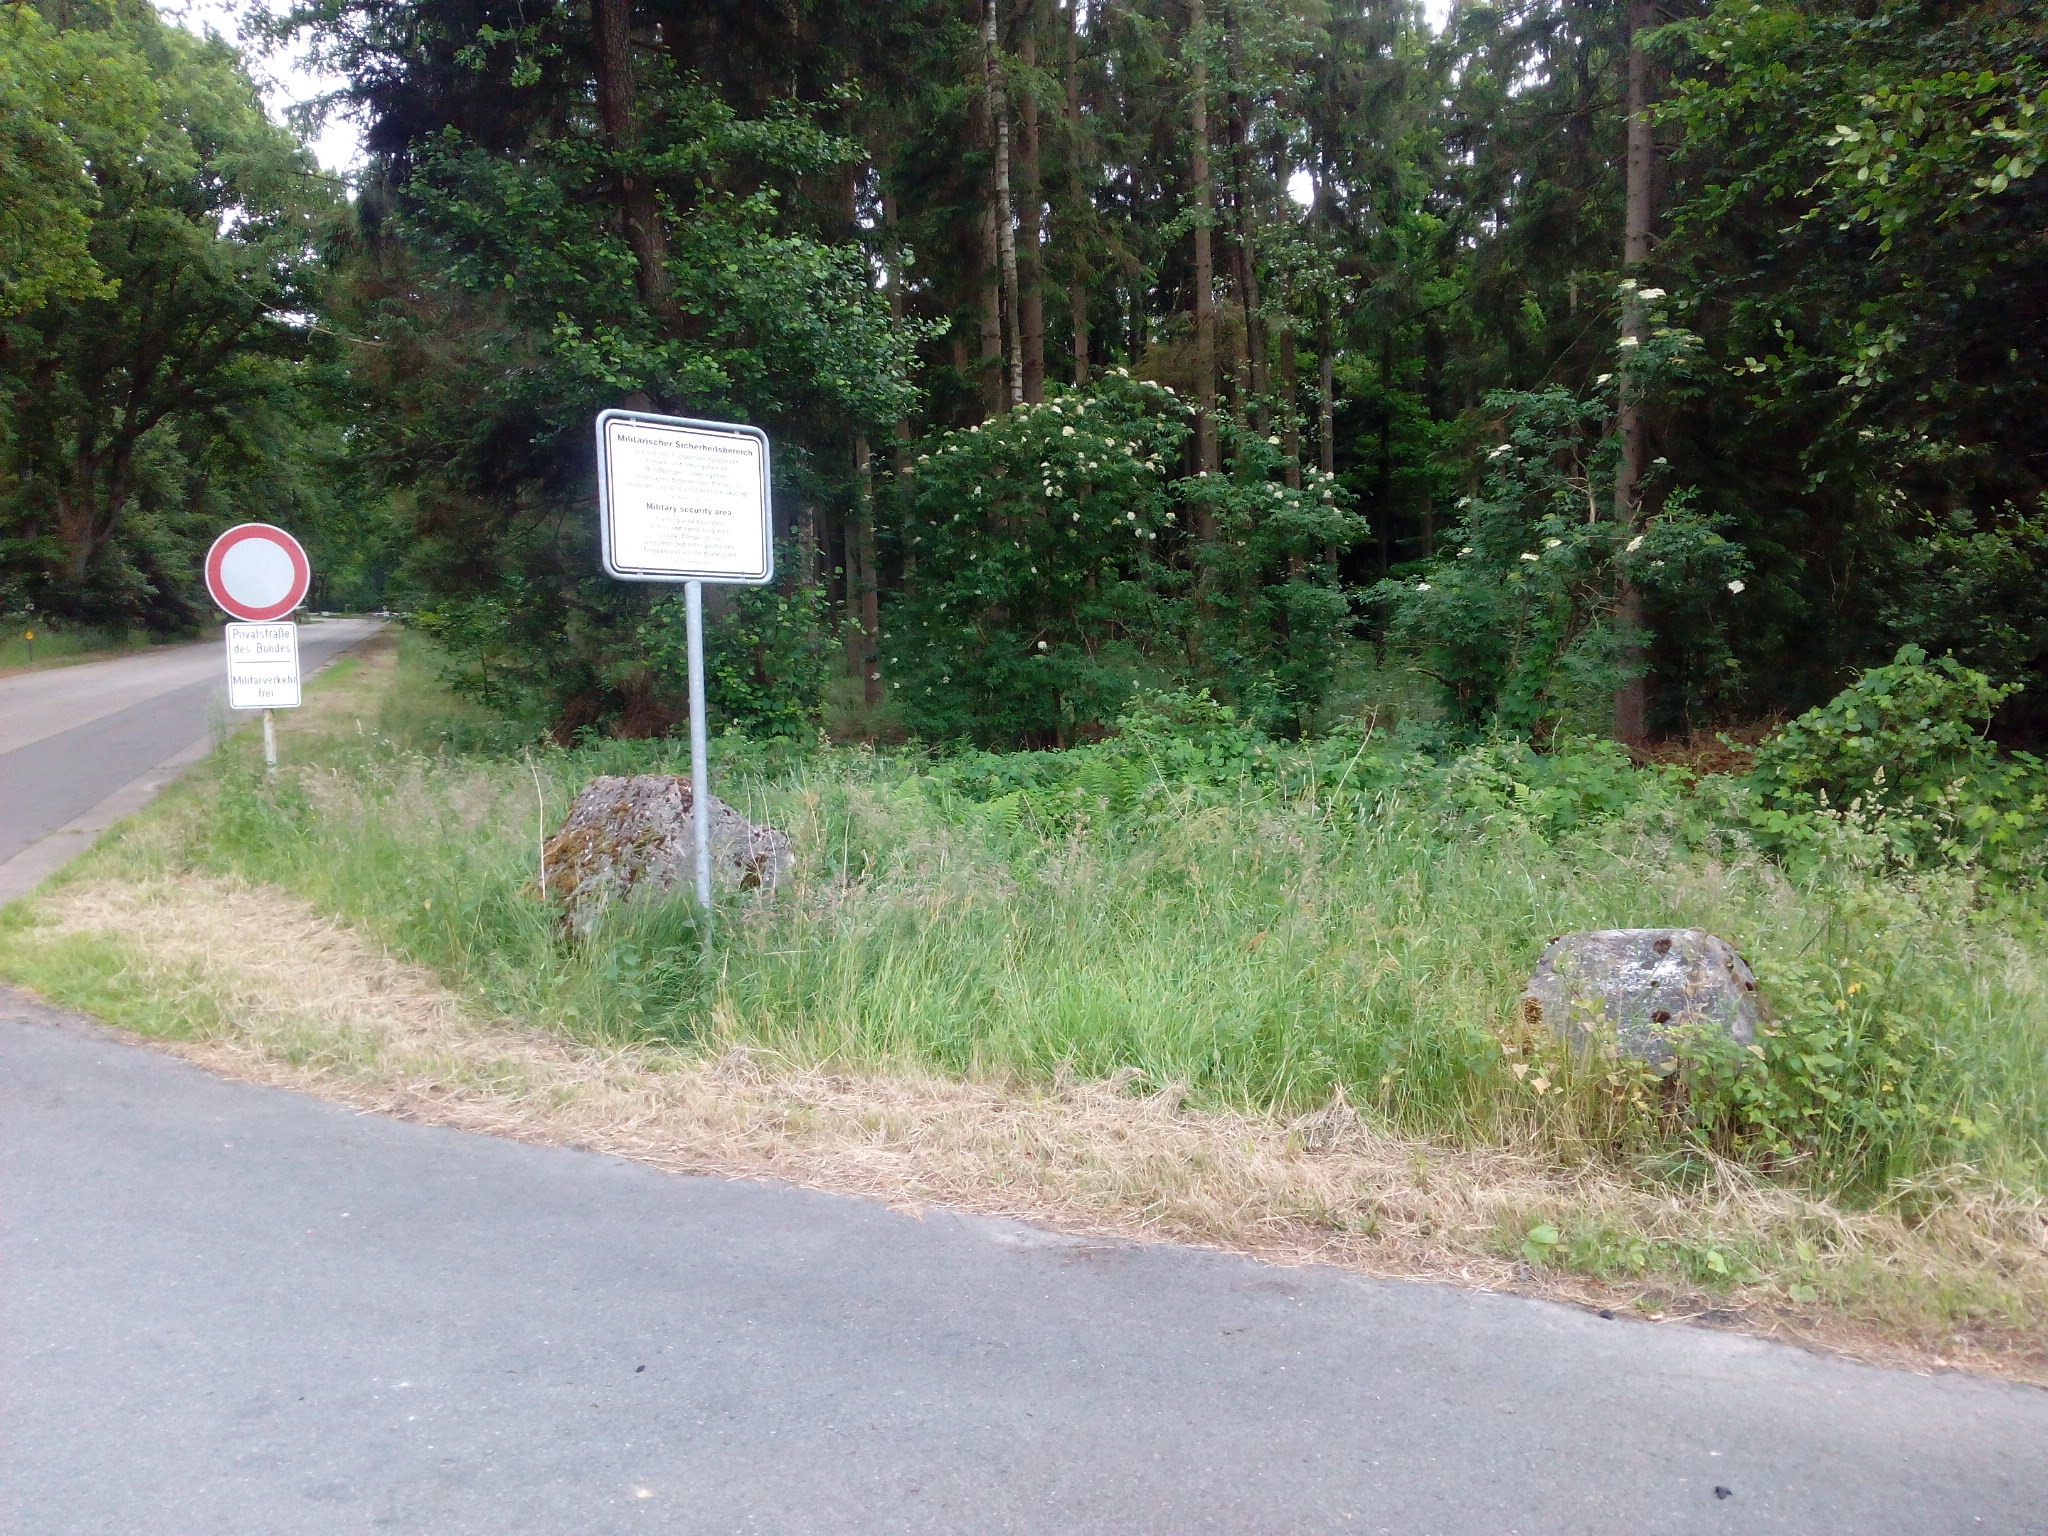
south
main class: Woodland
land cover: Pine dominated coniferous woodland
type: hemiboreal forest and nemoral coniferous forest and mixed broadleaved-coniferous forest
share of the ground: 50 - 75 %
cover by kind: coniferous forest trees 75 %, herbaceous plants 25 %
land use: Community services
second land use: Forestry
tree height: > 5 m
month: June
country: DE
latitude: 52.8806
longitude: 9.8663
